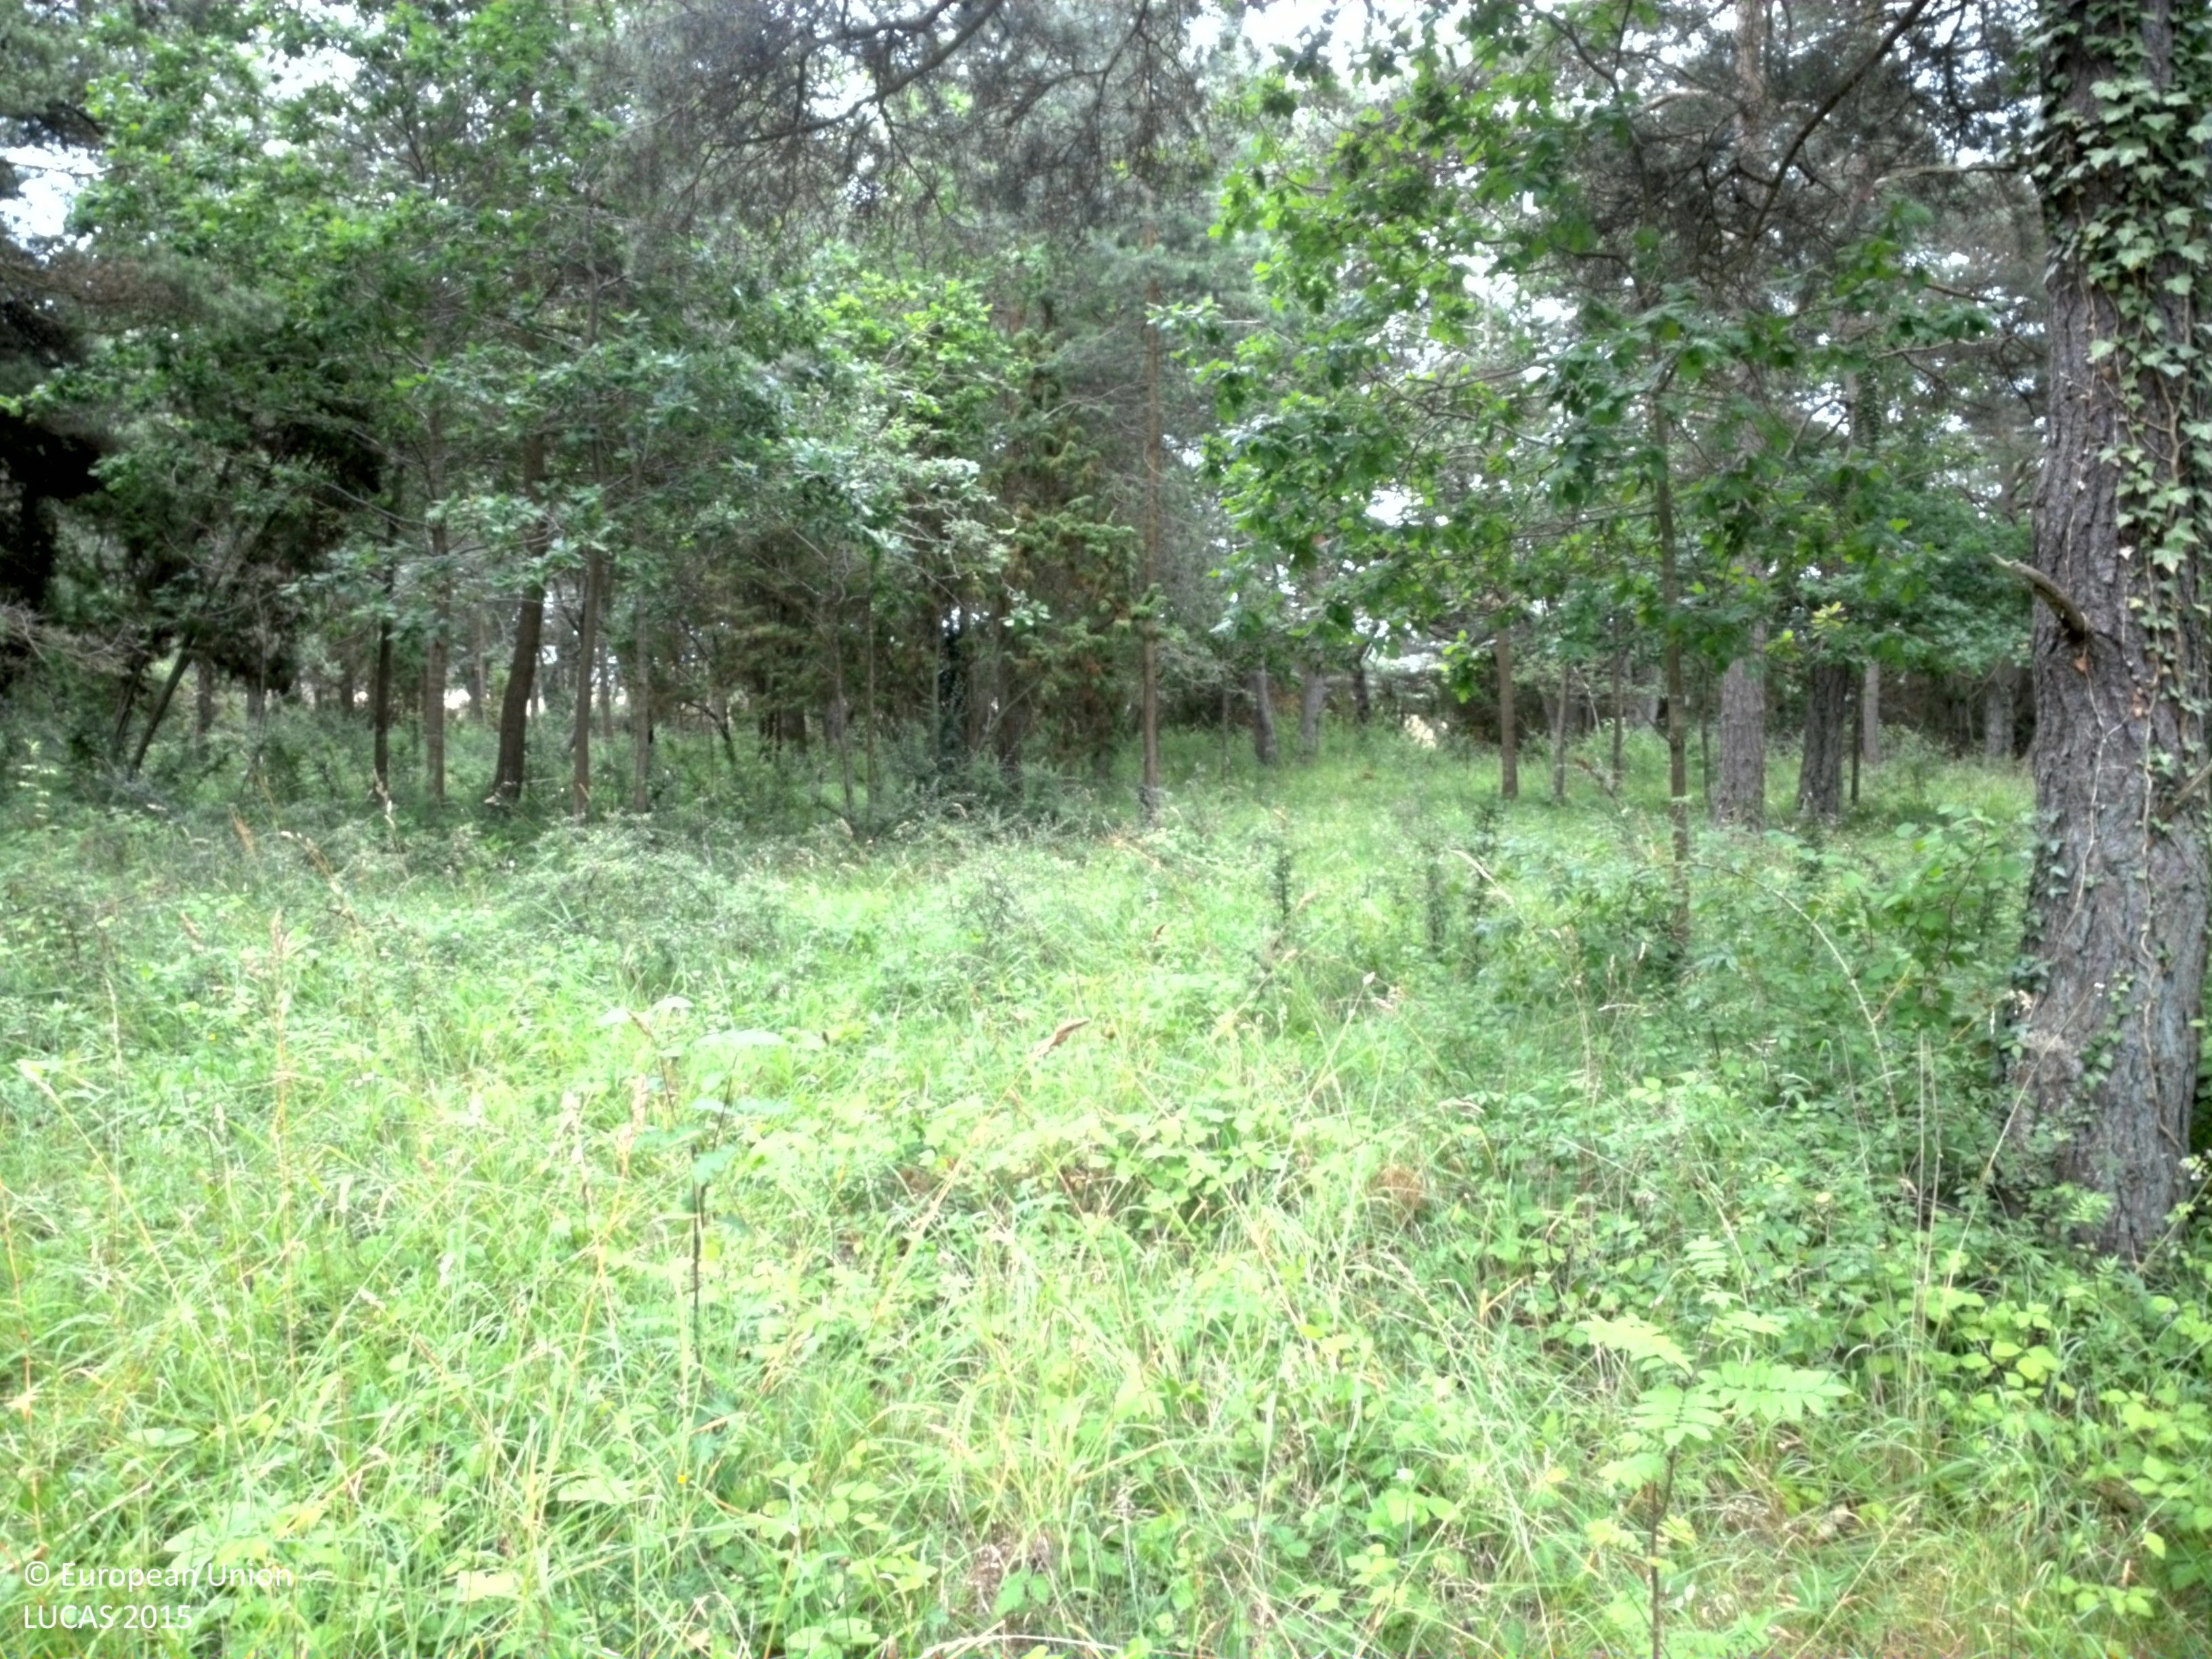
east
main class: Woodland
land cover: Pine dominated coniferous woodland
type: hemiboreal forest and nemoral coniferous forest and mixed broadleaved-coniferous forest
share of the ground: 25 - 50 %
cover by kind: coniferous forest trees 45 %, herbaceous plants 40 %, shrubs 10 %, broadleaved forest trees 5 %
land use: Forestry
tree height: > 5 m
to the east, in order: Pine dominated coniferous woodland; Fences; Tracks; Shrubland without tree cover; Grassland without tree/shrub cover; Ditches and canals; Grassland without tree/shrub cover
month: July
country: SE
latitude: 57.2684
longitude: 18.6833
